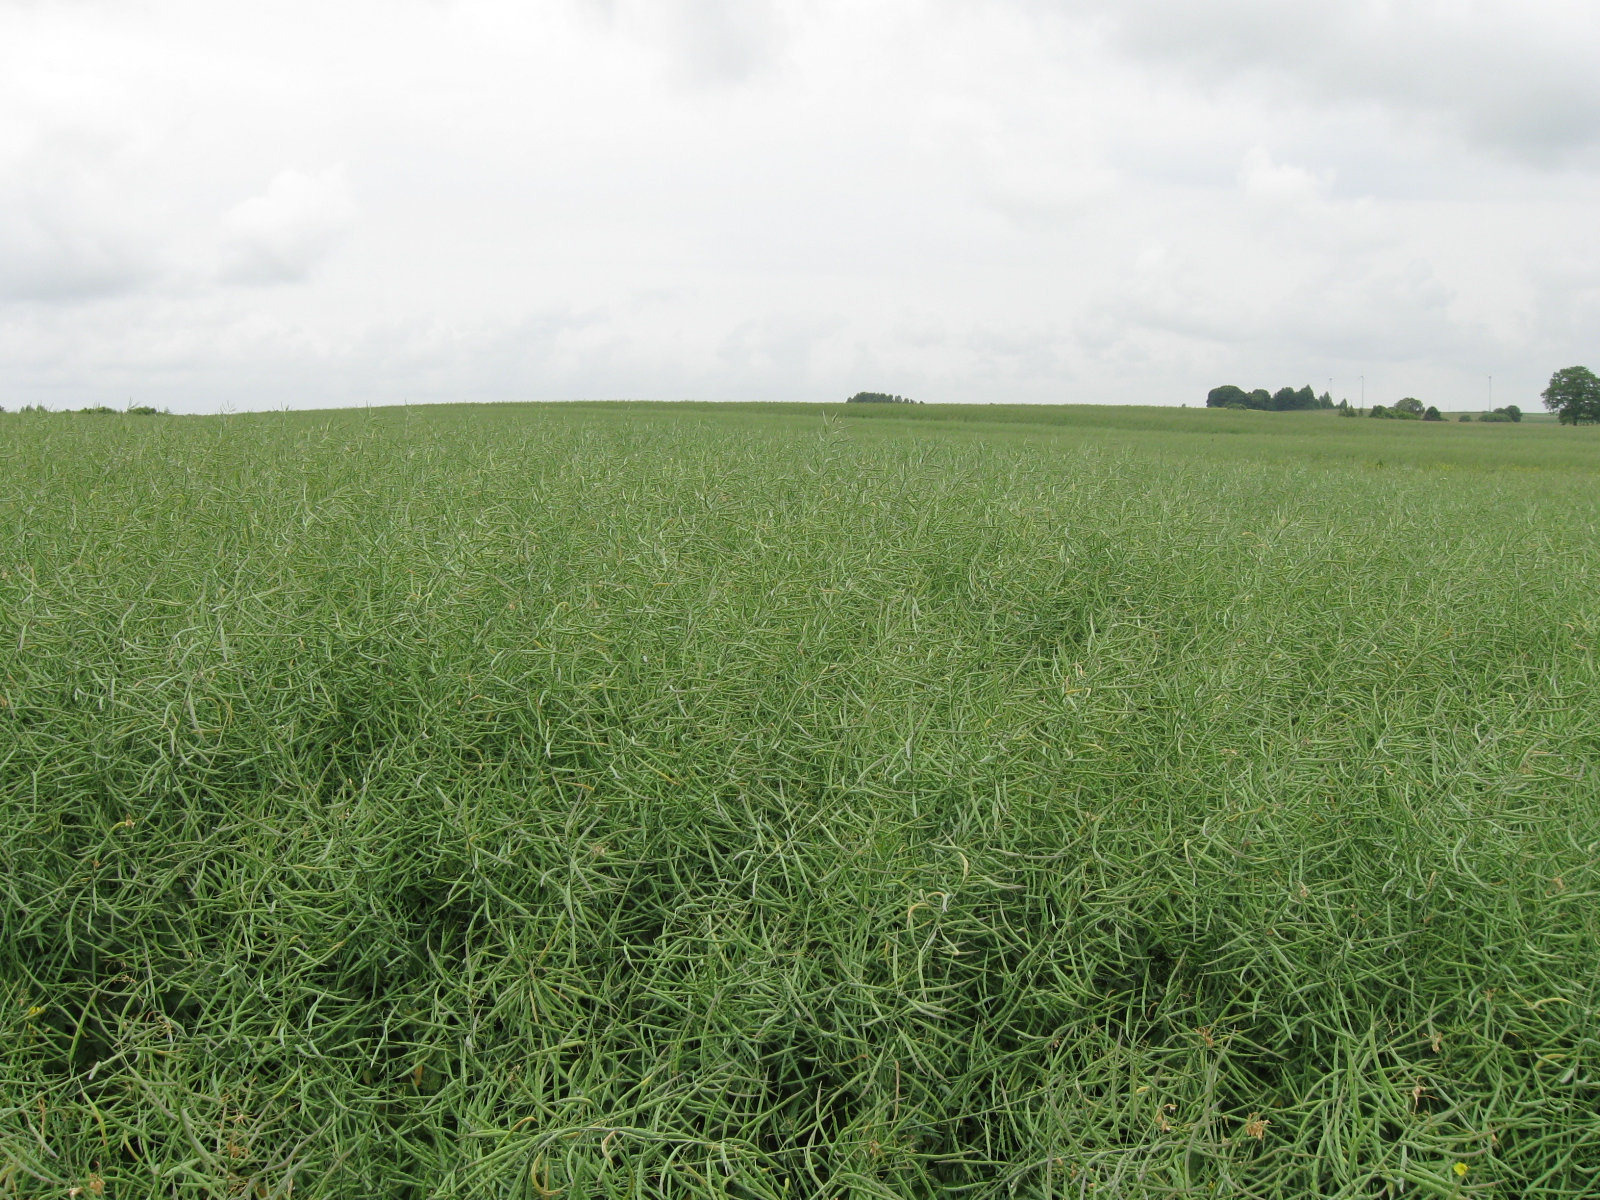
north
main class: Cropland
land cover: Rape and turnip rape
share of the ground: > 75 %
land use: Agriculture (excluding fallow land and kitchen gardens)
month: June
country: LT
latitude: 54.8937
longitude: 24.5569
